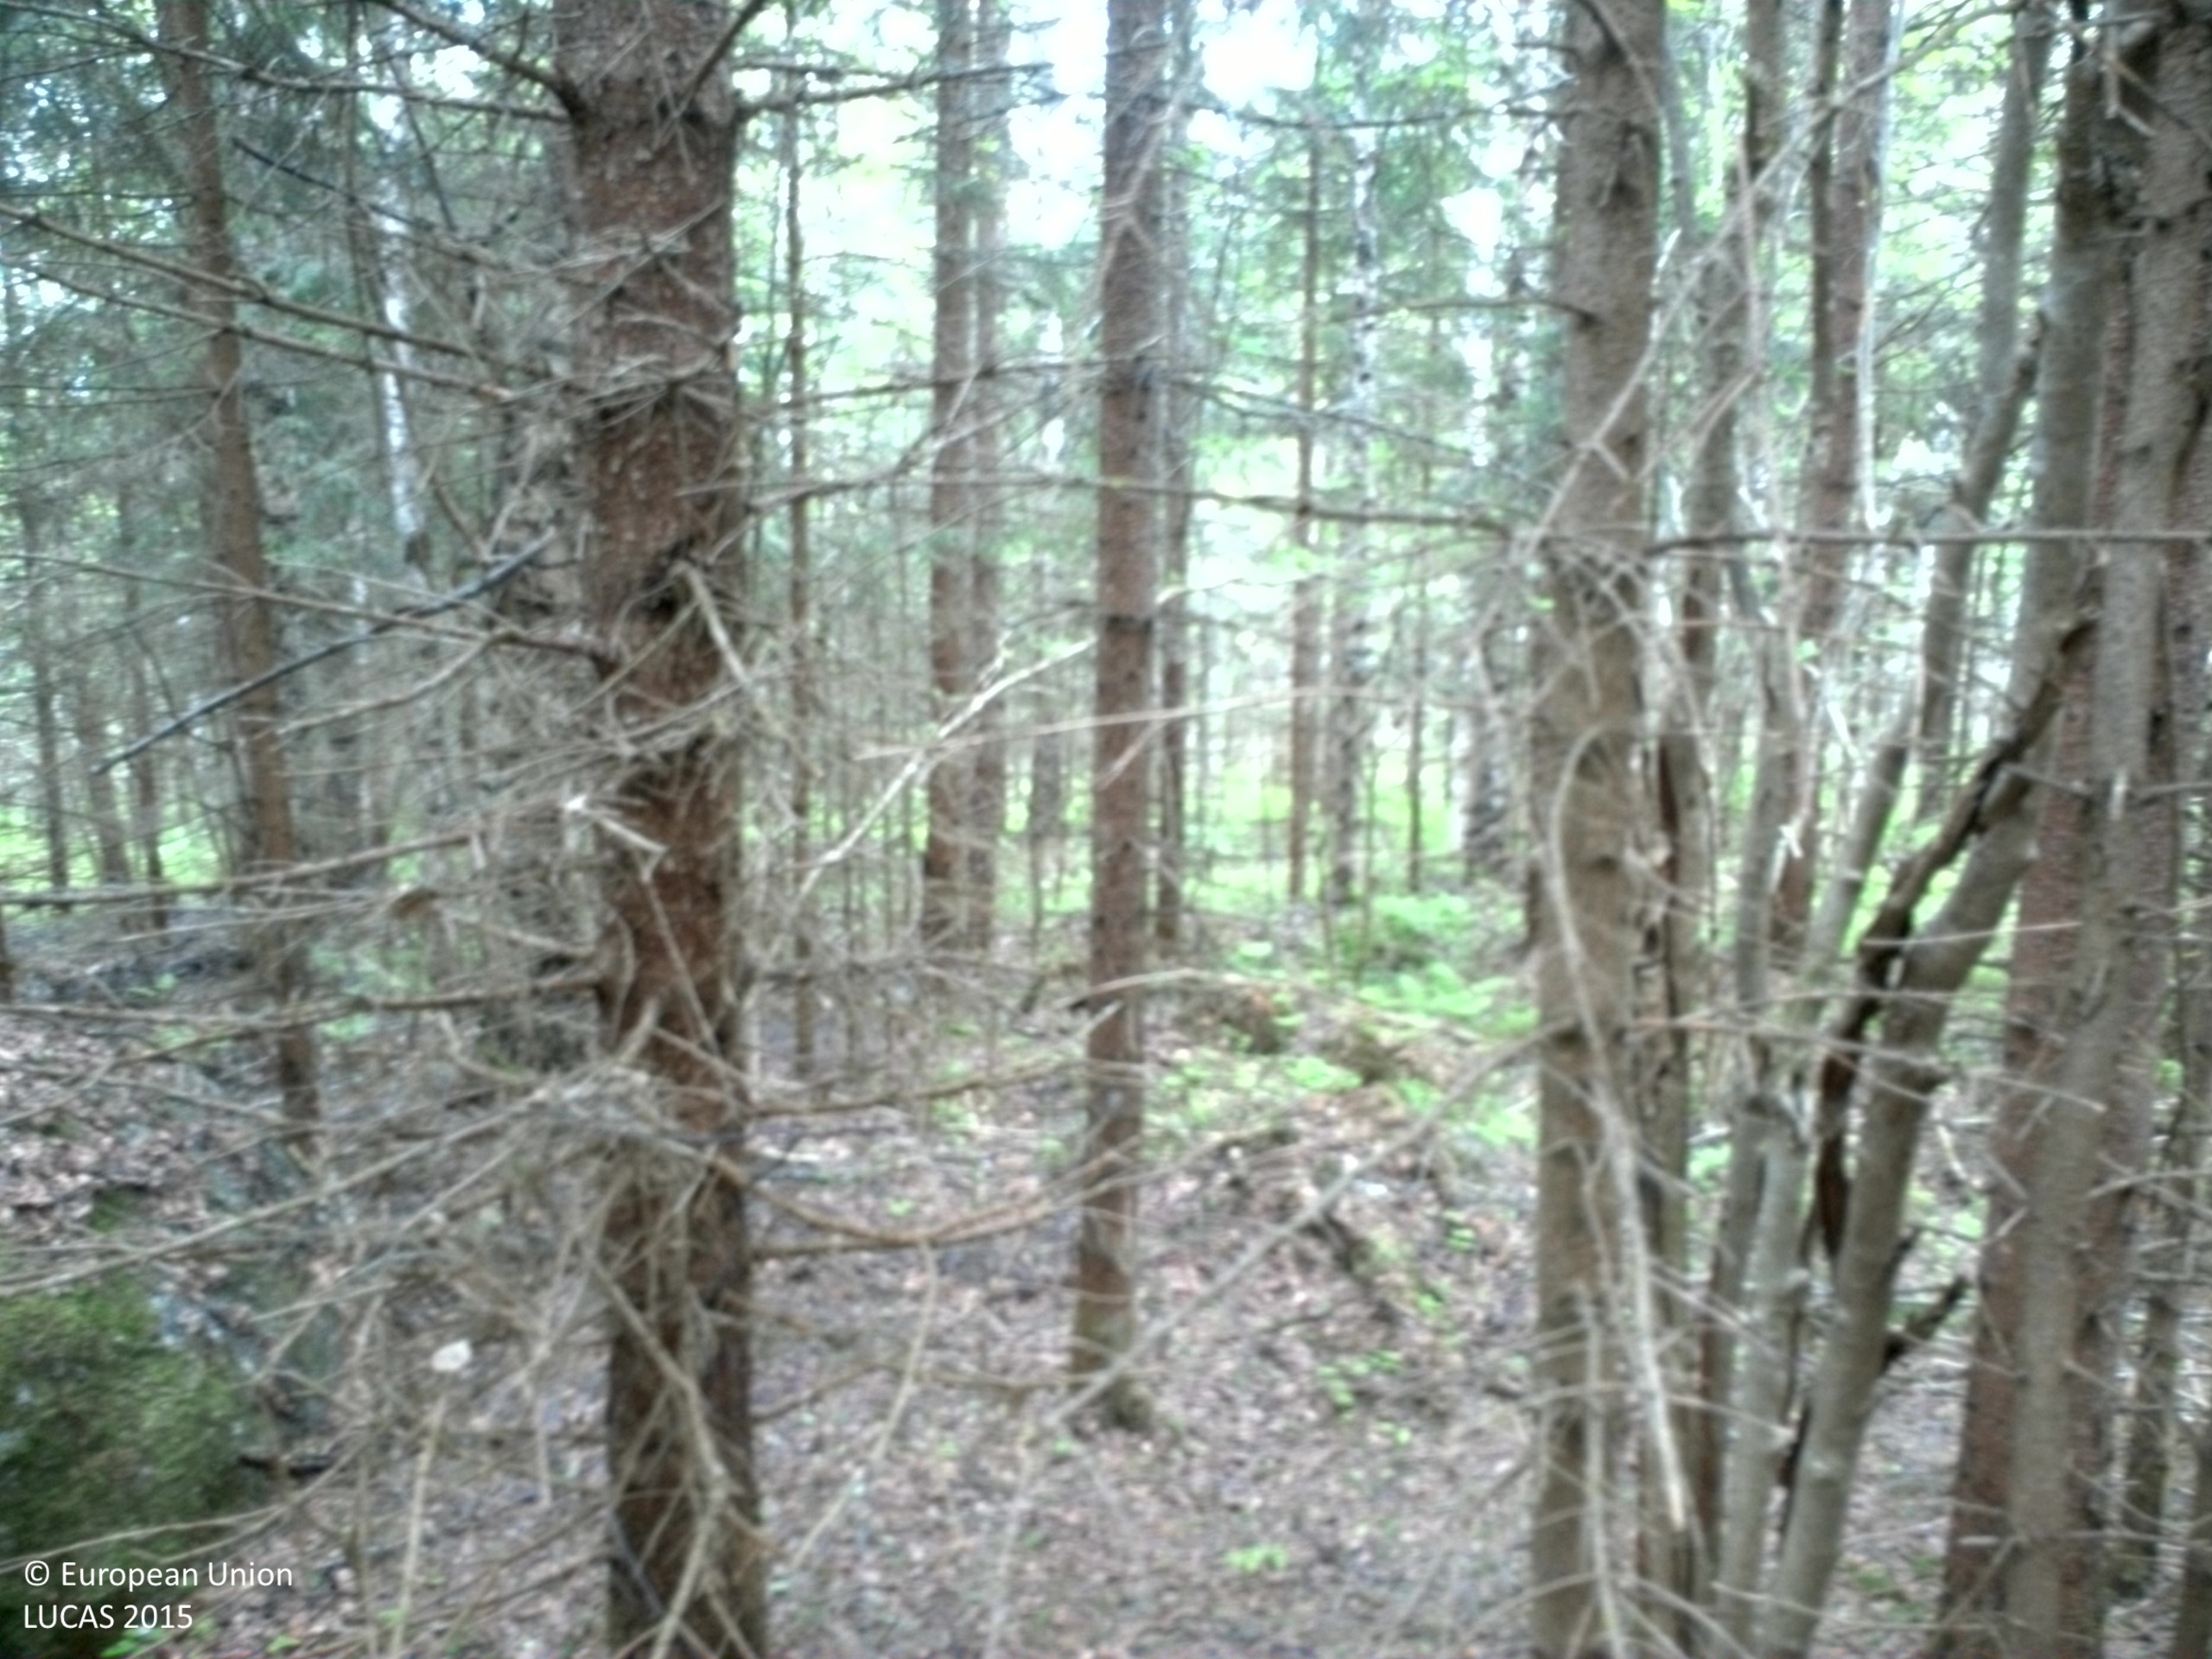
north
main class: Woodland
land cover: Spruce dominated coniferous woodland
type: boreal forest
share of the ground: > 75 %
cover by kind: coniferous forest trees 80 %, lichens and mosses 15 %, herbaceous plants 5 %
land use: Forestry
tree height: > 5 m
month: June
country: SE
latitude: 62.9438
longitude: 17.9987
